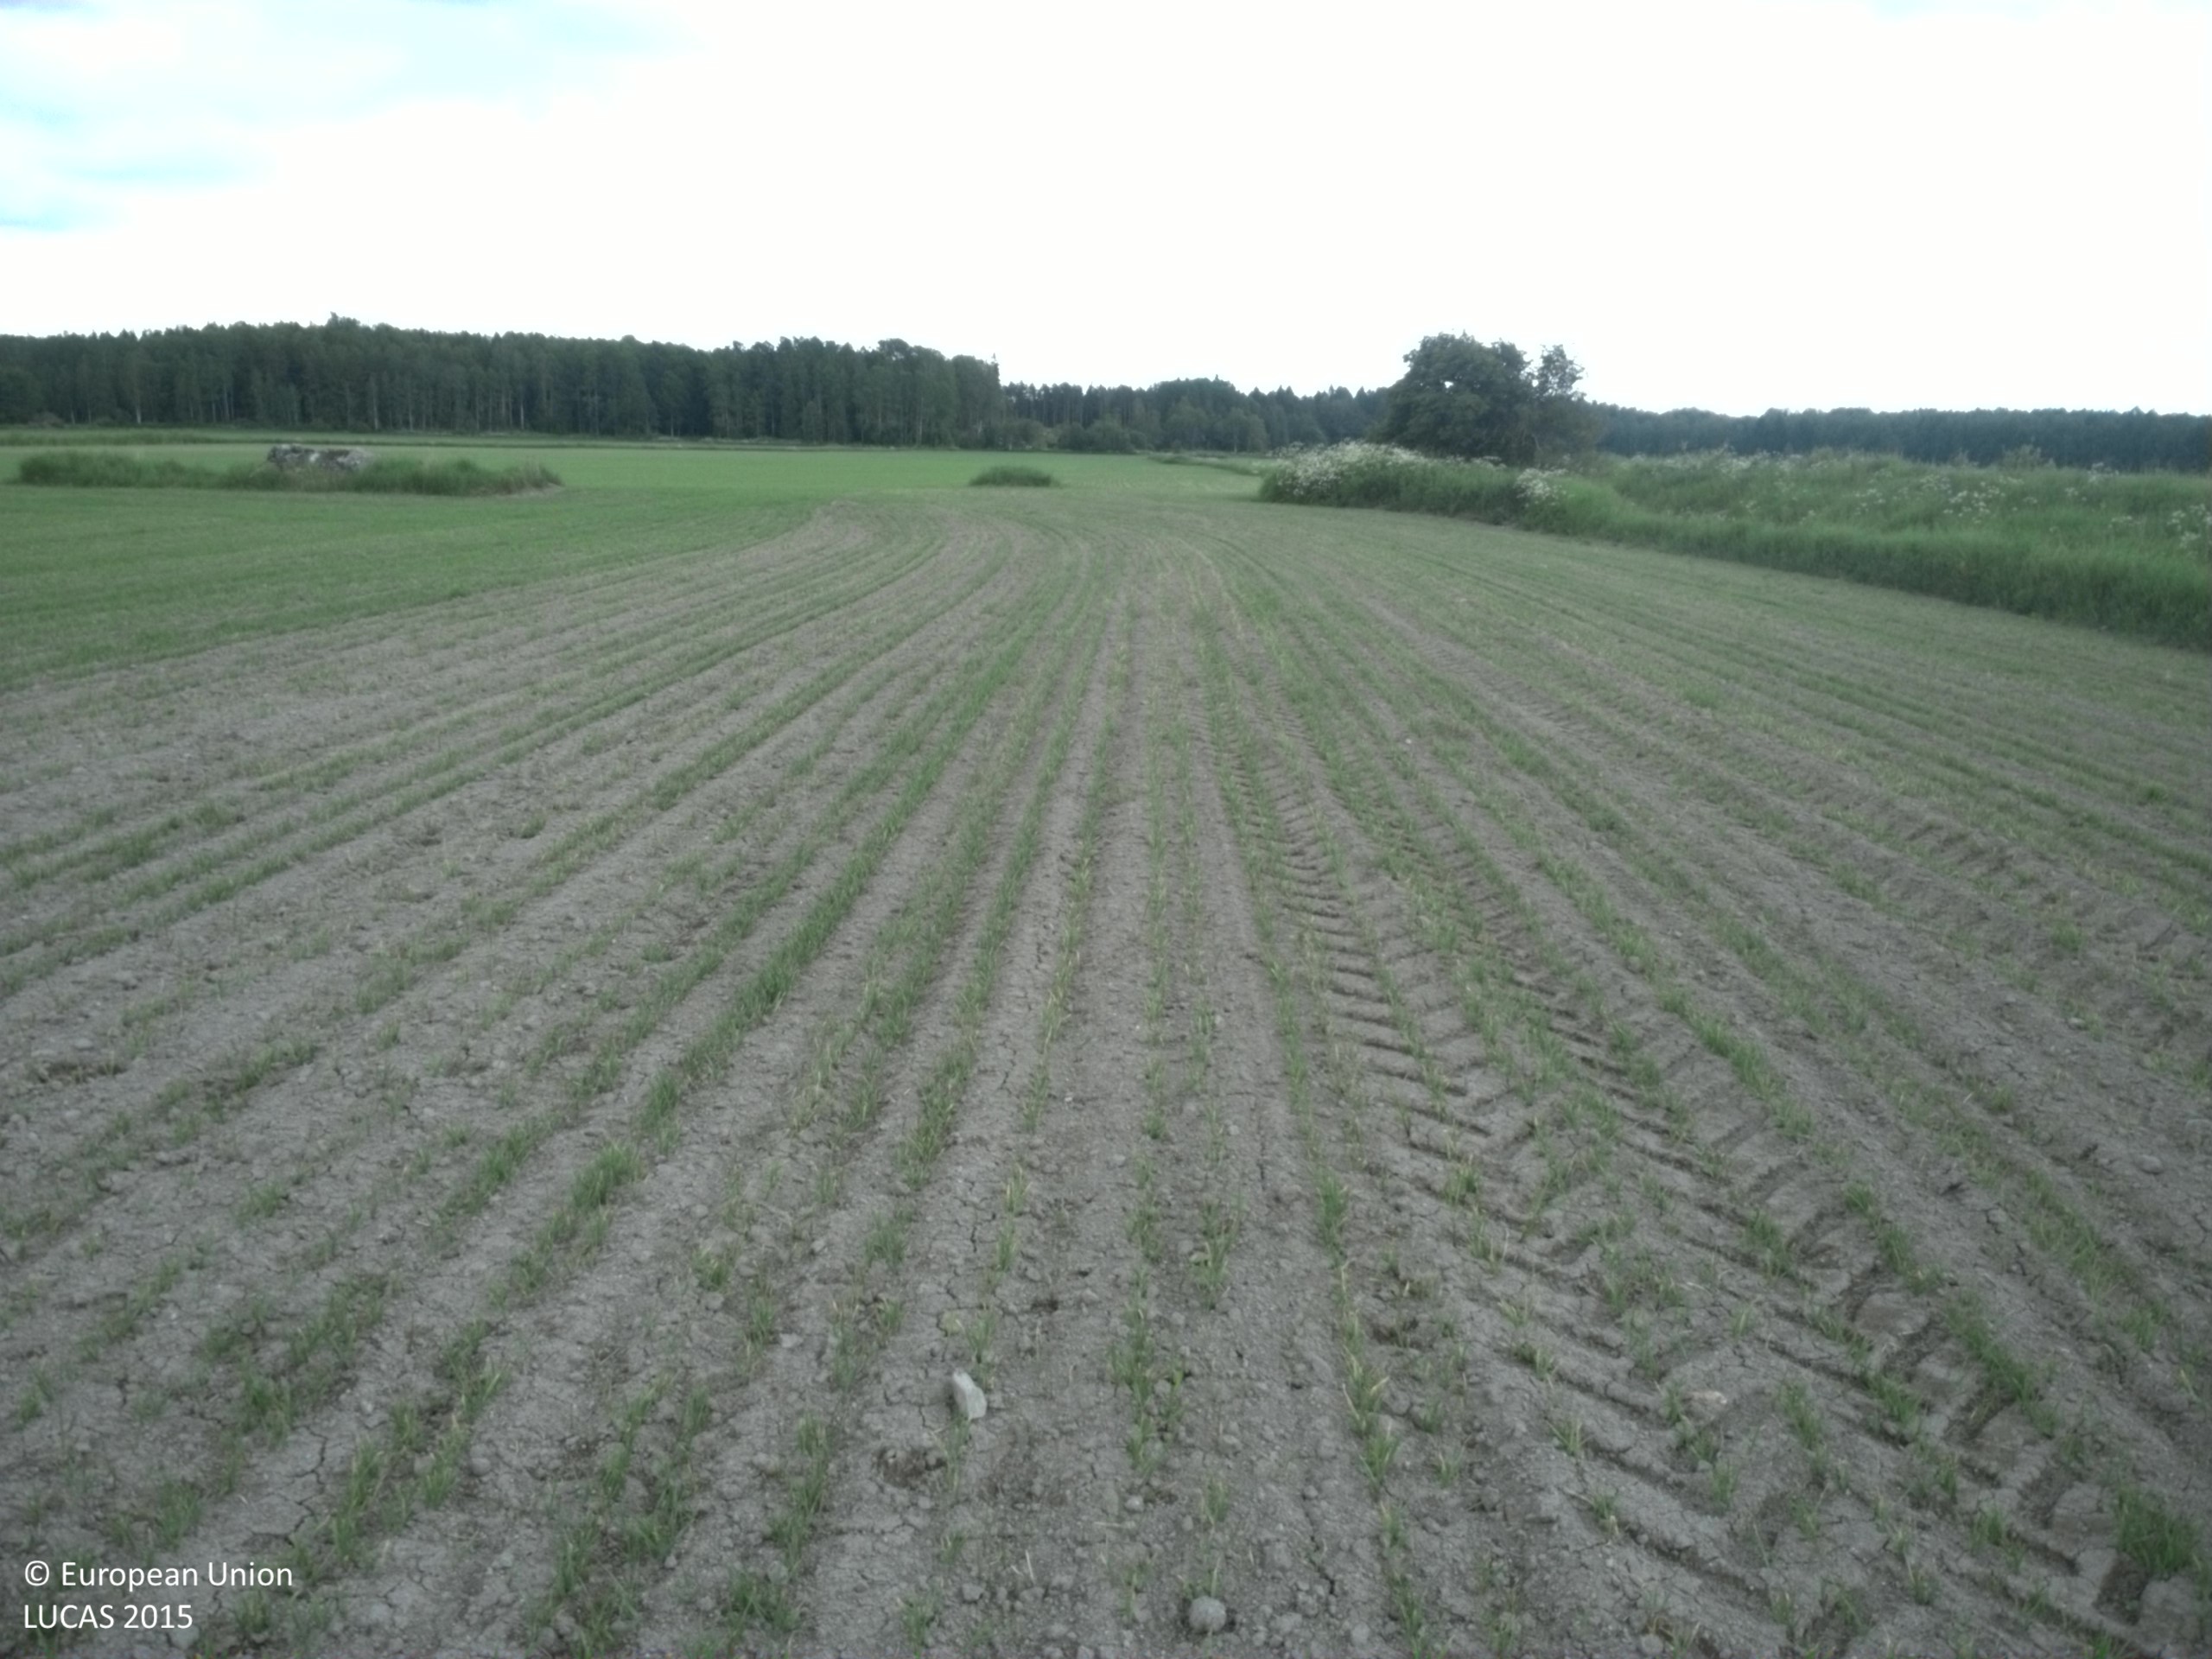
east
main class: Cropland
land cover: Barley
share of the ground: 25 - 50 %
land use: Agriculture (excluding fallow land and kitchen gardens)
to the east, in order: Barley; Grassland without tree/shrub cover; Barley; Grass margins; Ditches and canals; Grass margins; Barley
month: June
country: SE
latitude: 60.2950
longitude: 17.7177
